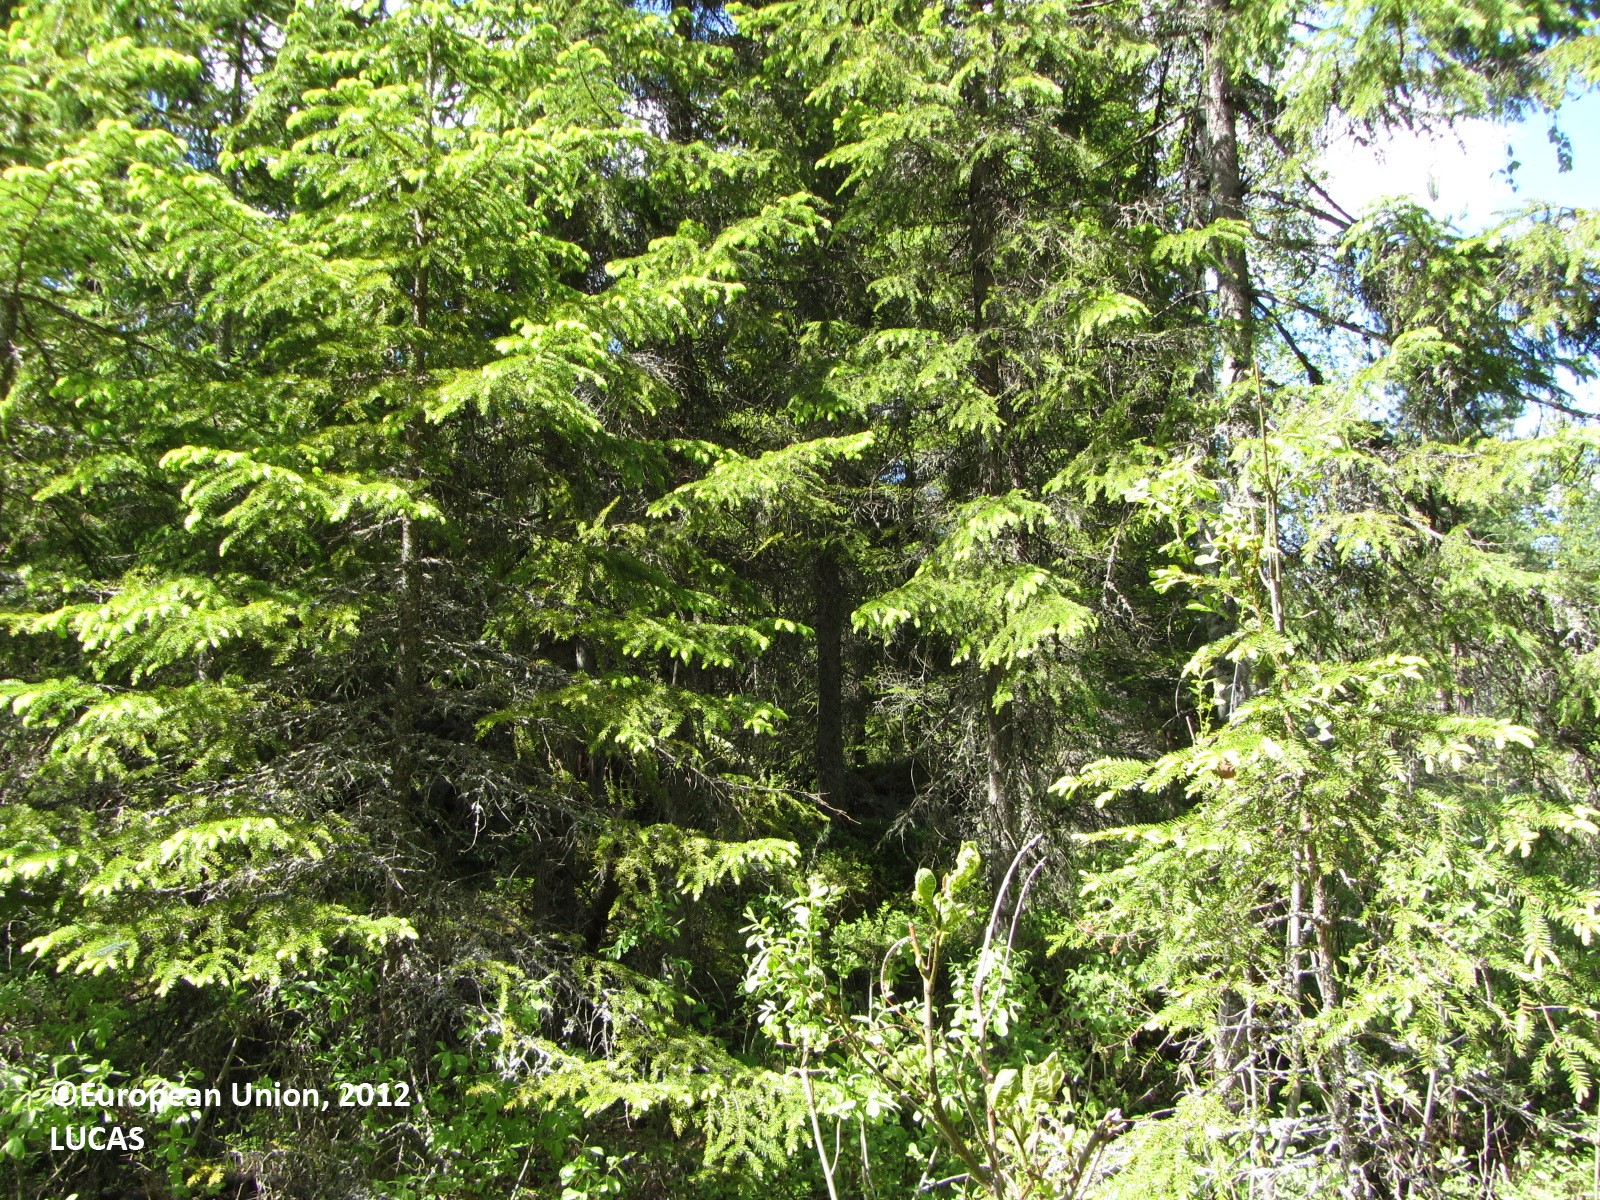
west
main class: Woodland
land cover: Spruce dominated mixed woodland
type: boreal forest
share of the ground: > 75 %
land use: Forestry
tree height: > 5 m
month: June
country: FI
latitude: 61.6754
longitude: 25.1309
